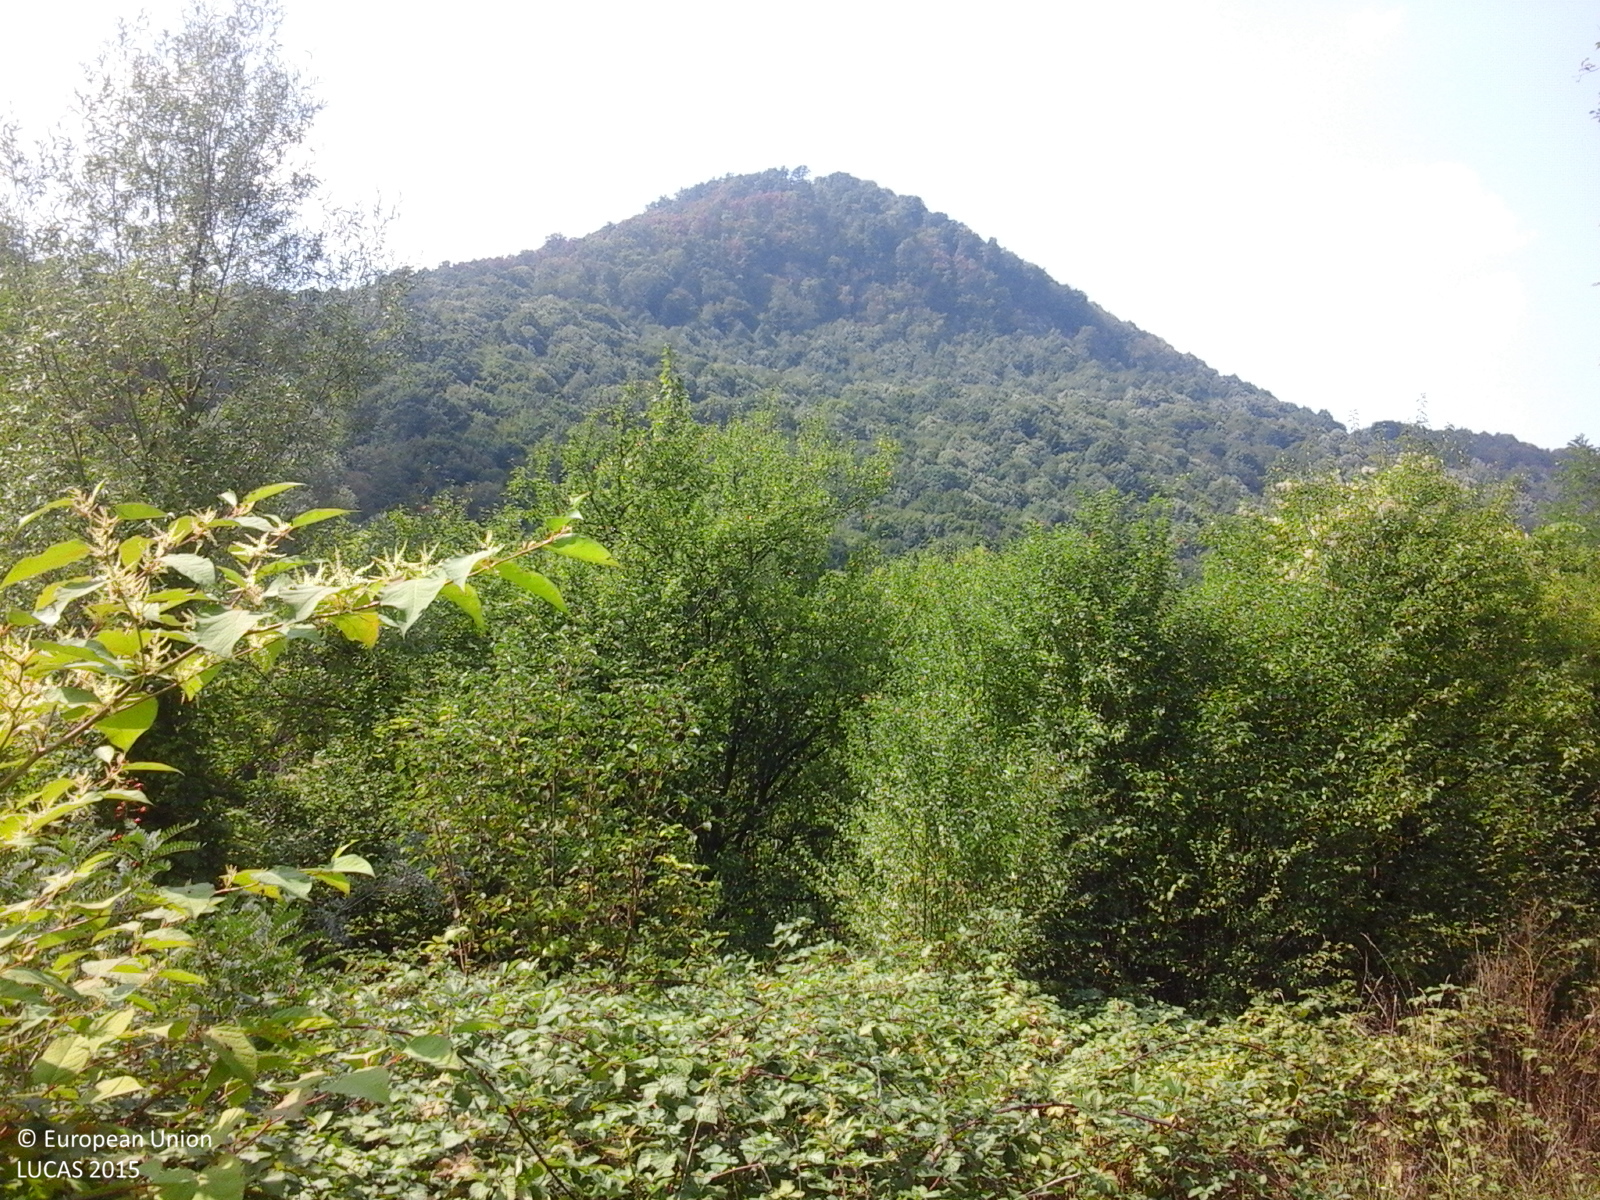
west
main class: Woodland
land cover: Broadleaved woodland
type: acidophilous oak and oak-birch forest
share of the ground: > 75 %
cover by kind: broadleaved forest trees 100 %
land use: Forestry
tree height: > 5 m
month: August
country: RO
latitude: 46.2772
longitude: 22.4427
